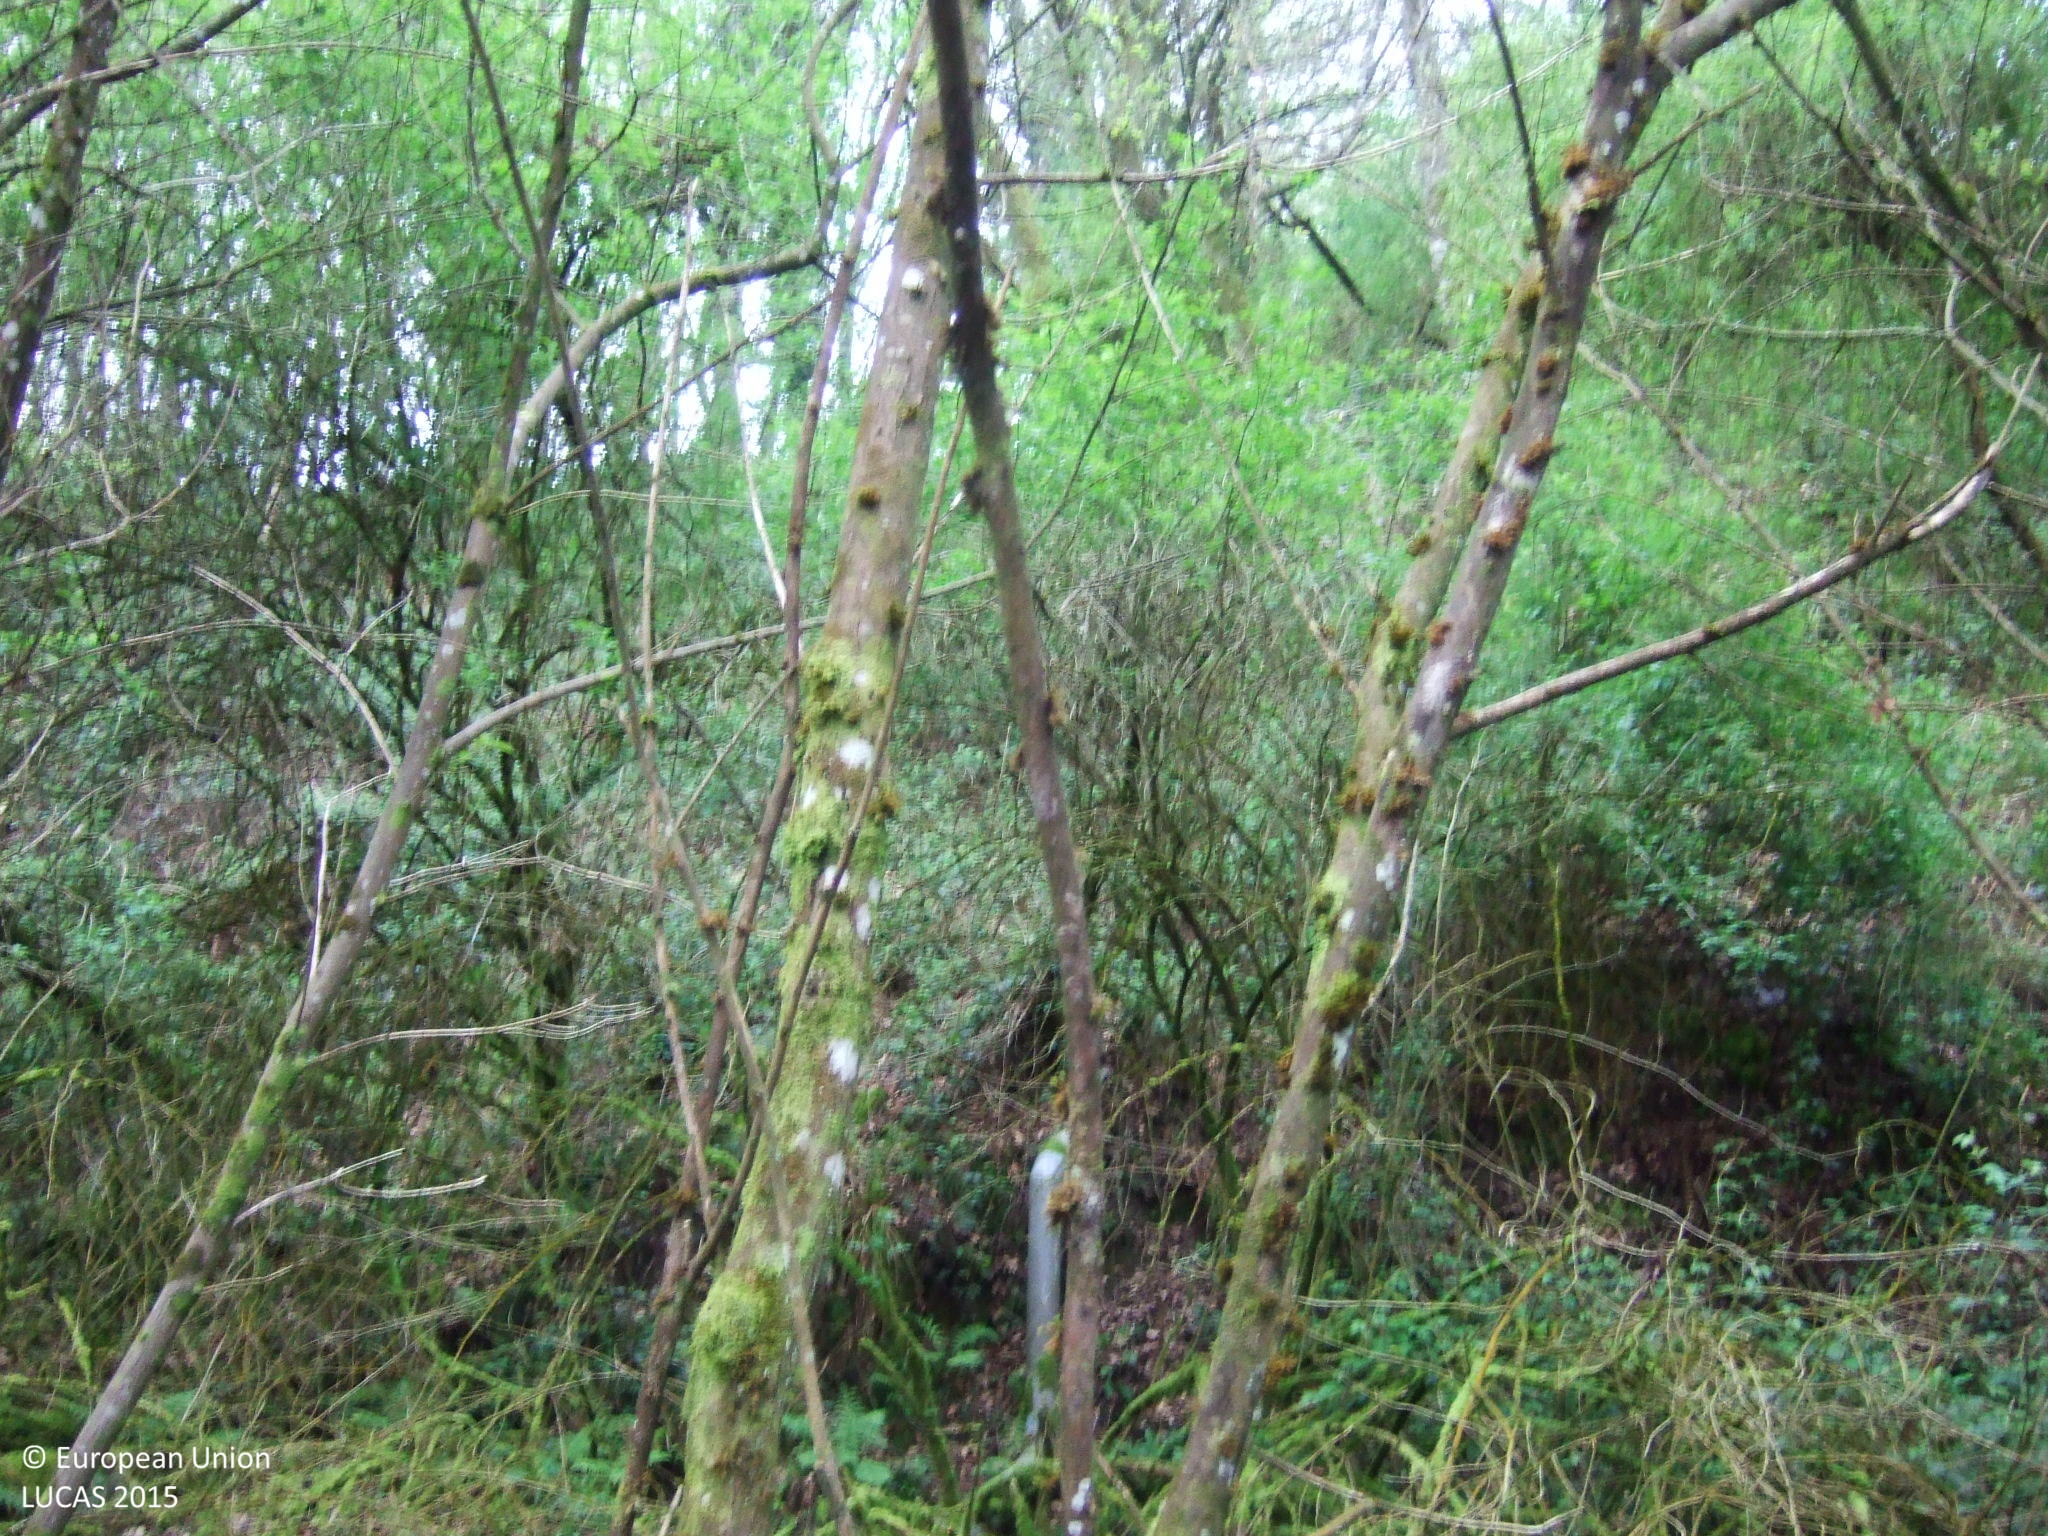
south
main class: Woodland
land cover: Broadleaved woodland
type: floodplain forest
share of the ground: > 75 %
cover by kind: broadleaved forest trees 90 %, shrubs 10 %
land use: Forestry
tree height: > 5 m
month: April
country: ES
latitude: 42.9481
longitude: -7.5666
